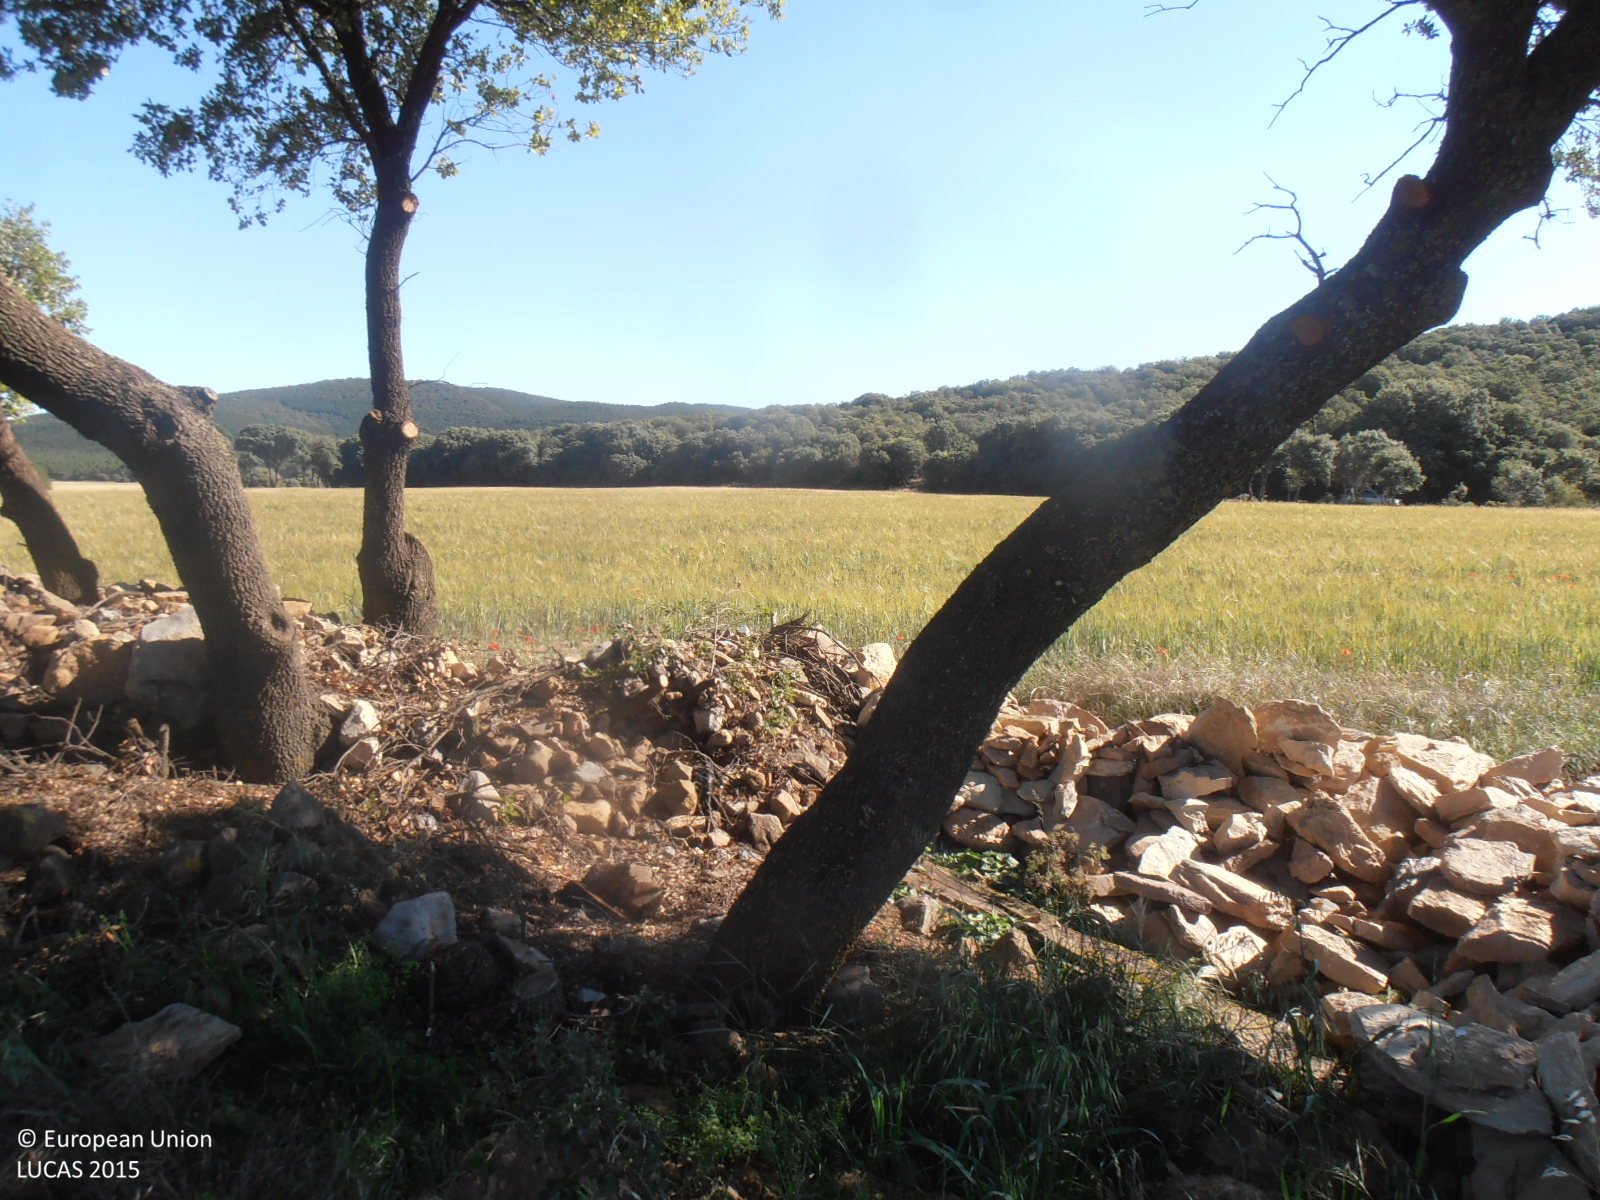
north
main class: Cropland
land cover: Barley
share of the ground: > 75 %
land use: Agriculture (excluding fallow land and kitchen gardens)
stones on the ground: < 10 %
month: June
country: ES
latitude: 41.7883
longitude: -2.0303
